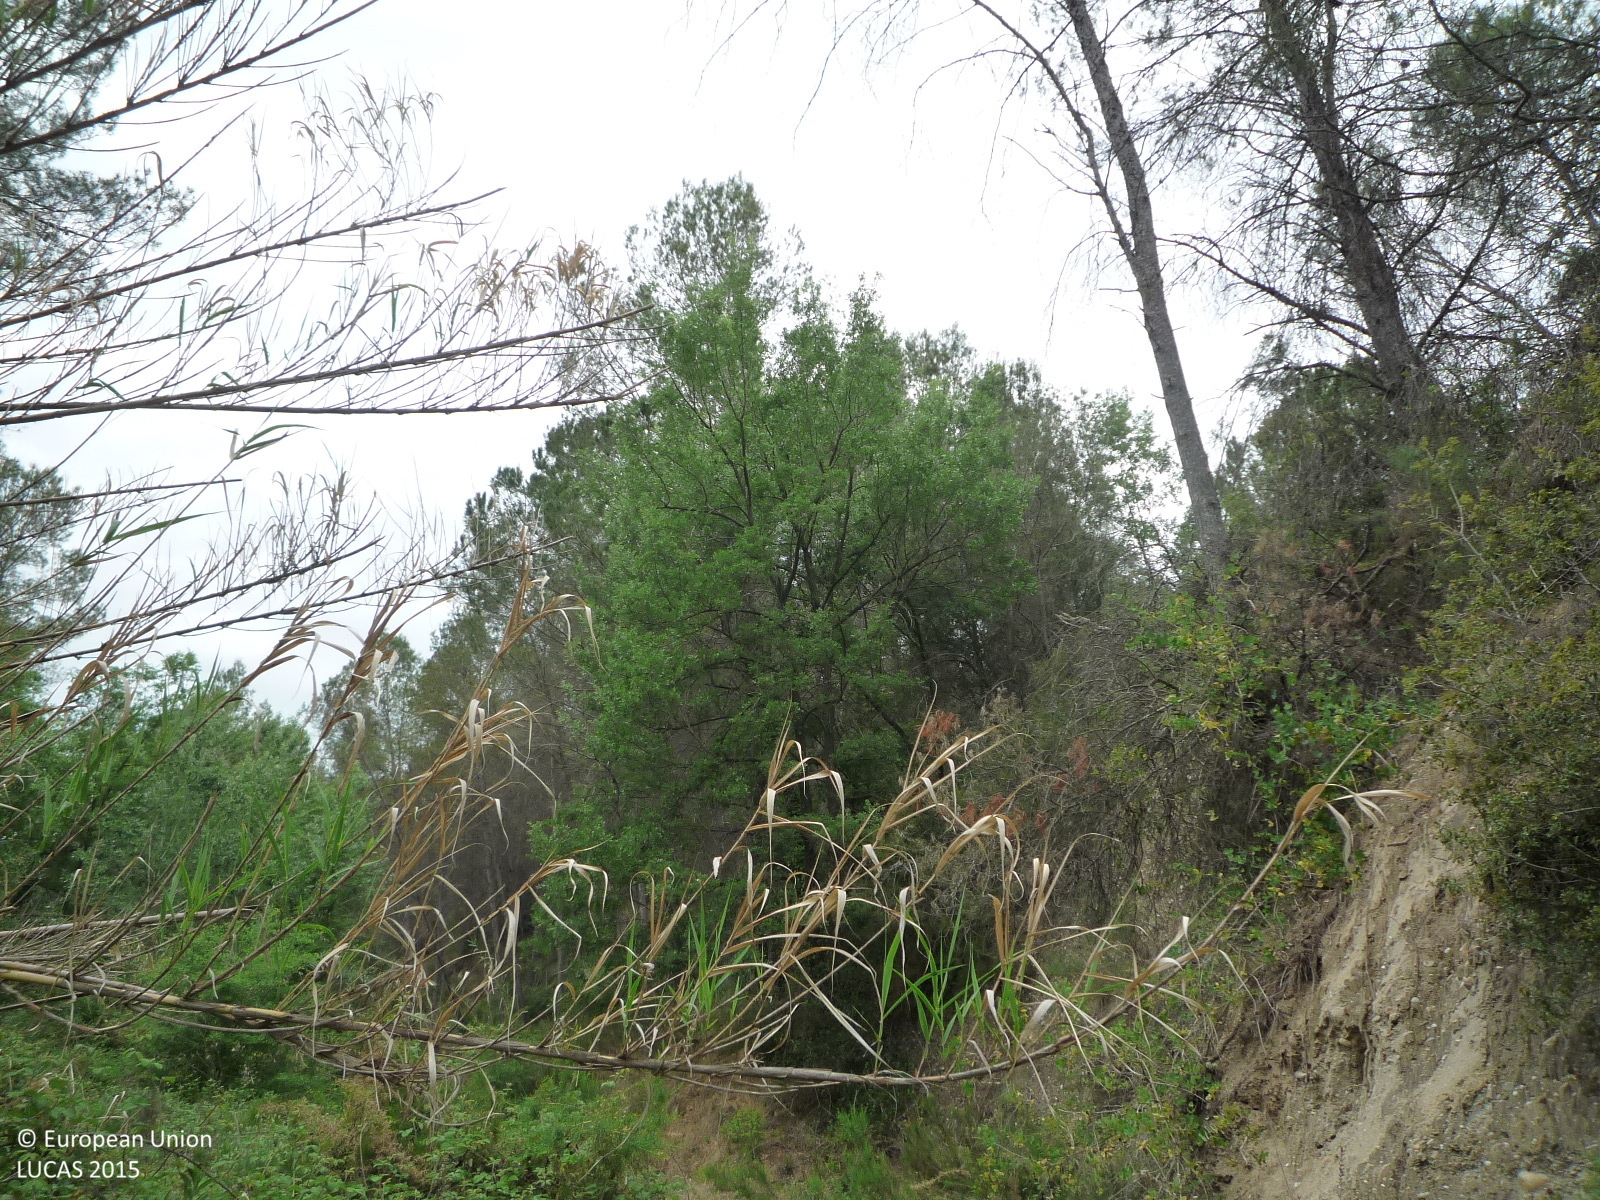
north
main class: Woodland
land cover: Pine dominated coniferous woodland
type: coniferous forest of the mediterranean region
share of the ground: > 75 %
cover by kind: coniferous forest trees 100 %
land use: Semi-natural and natural areas not in use
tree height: > 5 m
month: May
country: ES
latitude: 41.4872
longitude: 1.8124
